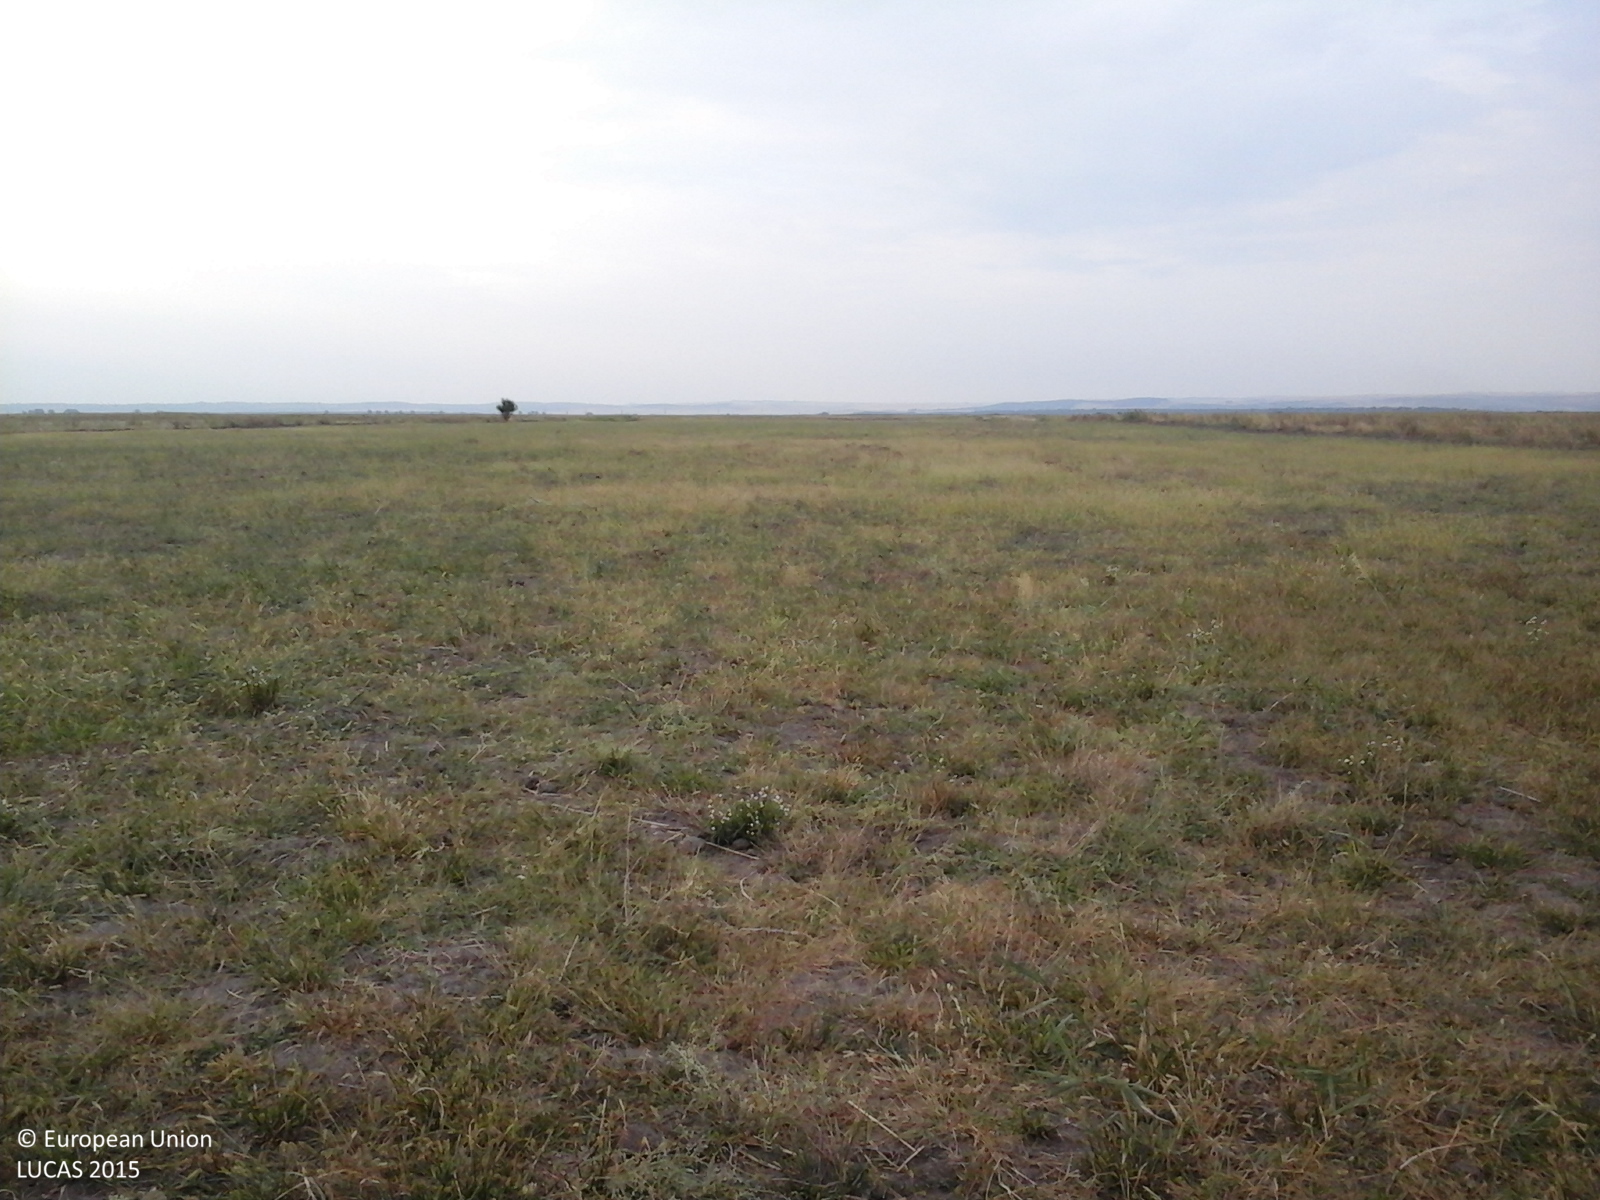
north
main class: Grassland
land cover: Grassland without tree/shrub cover
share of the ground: > 75 %
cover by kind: herbaceous plants 100 %
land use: Agriculture (excluding fallow land and kitchen gardens)
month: August
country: RO
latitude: 44.3745
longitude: 22.8051
